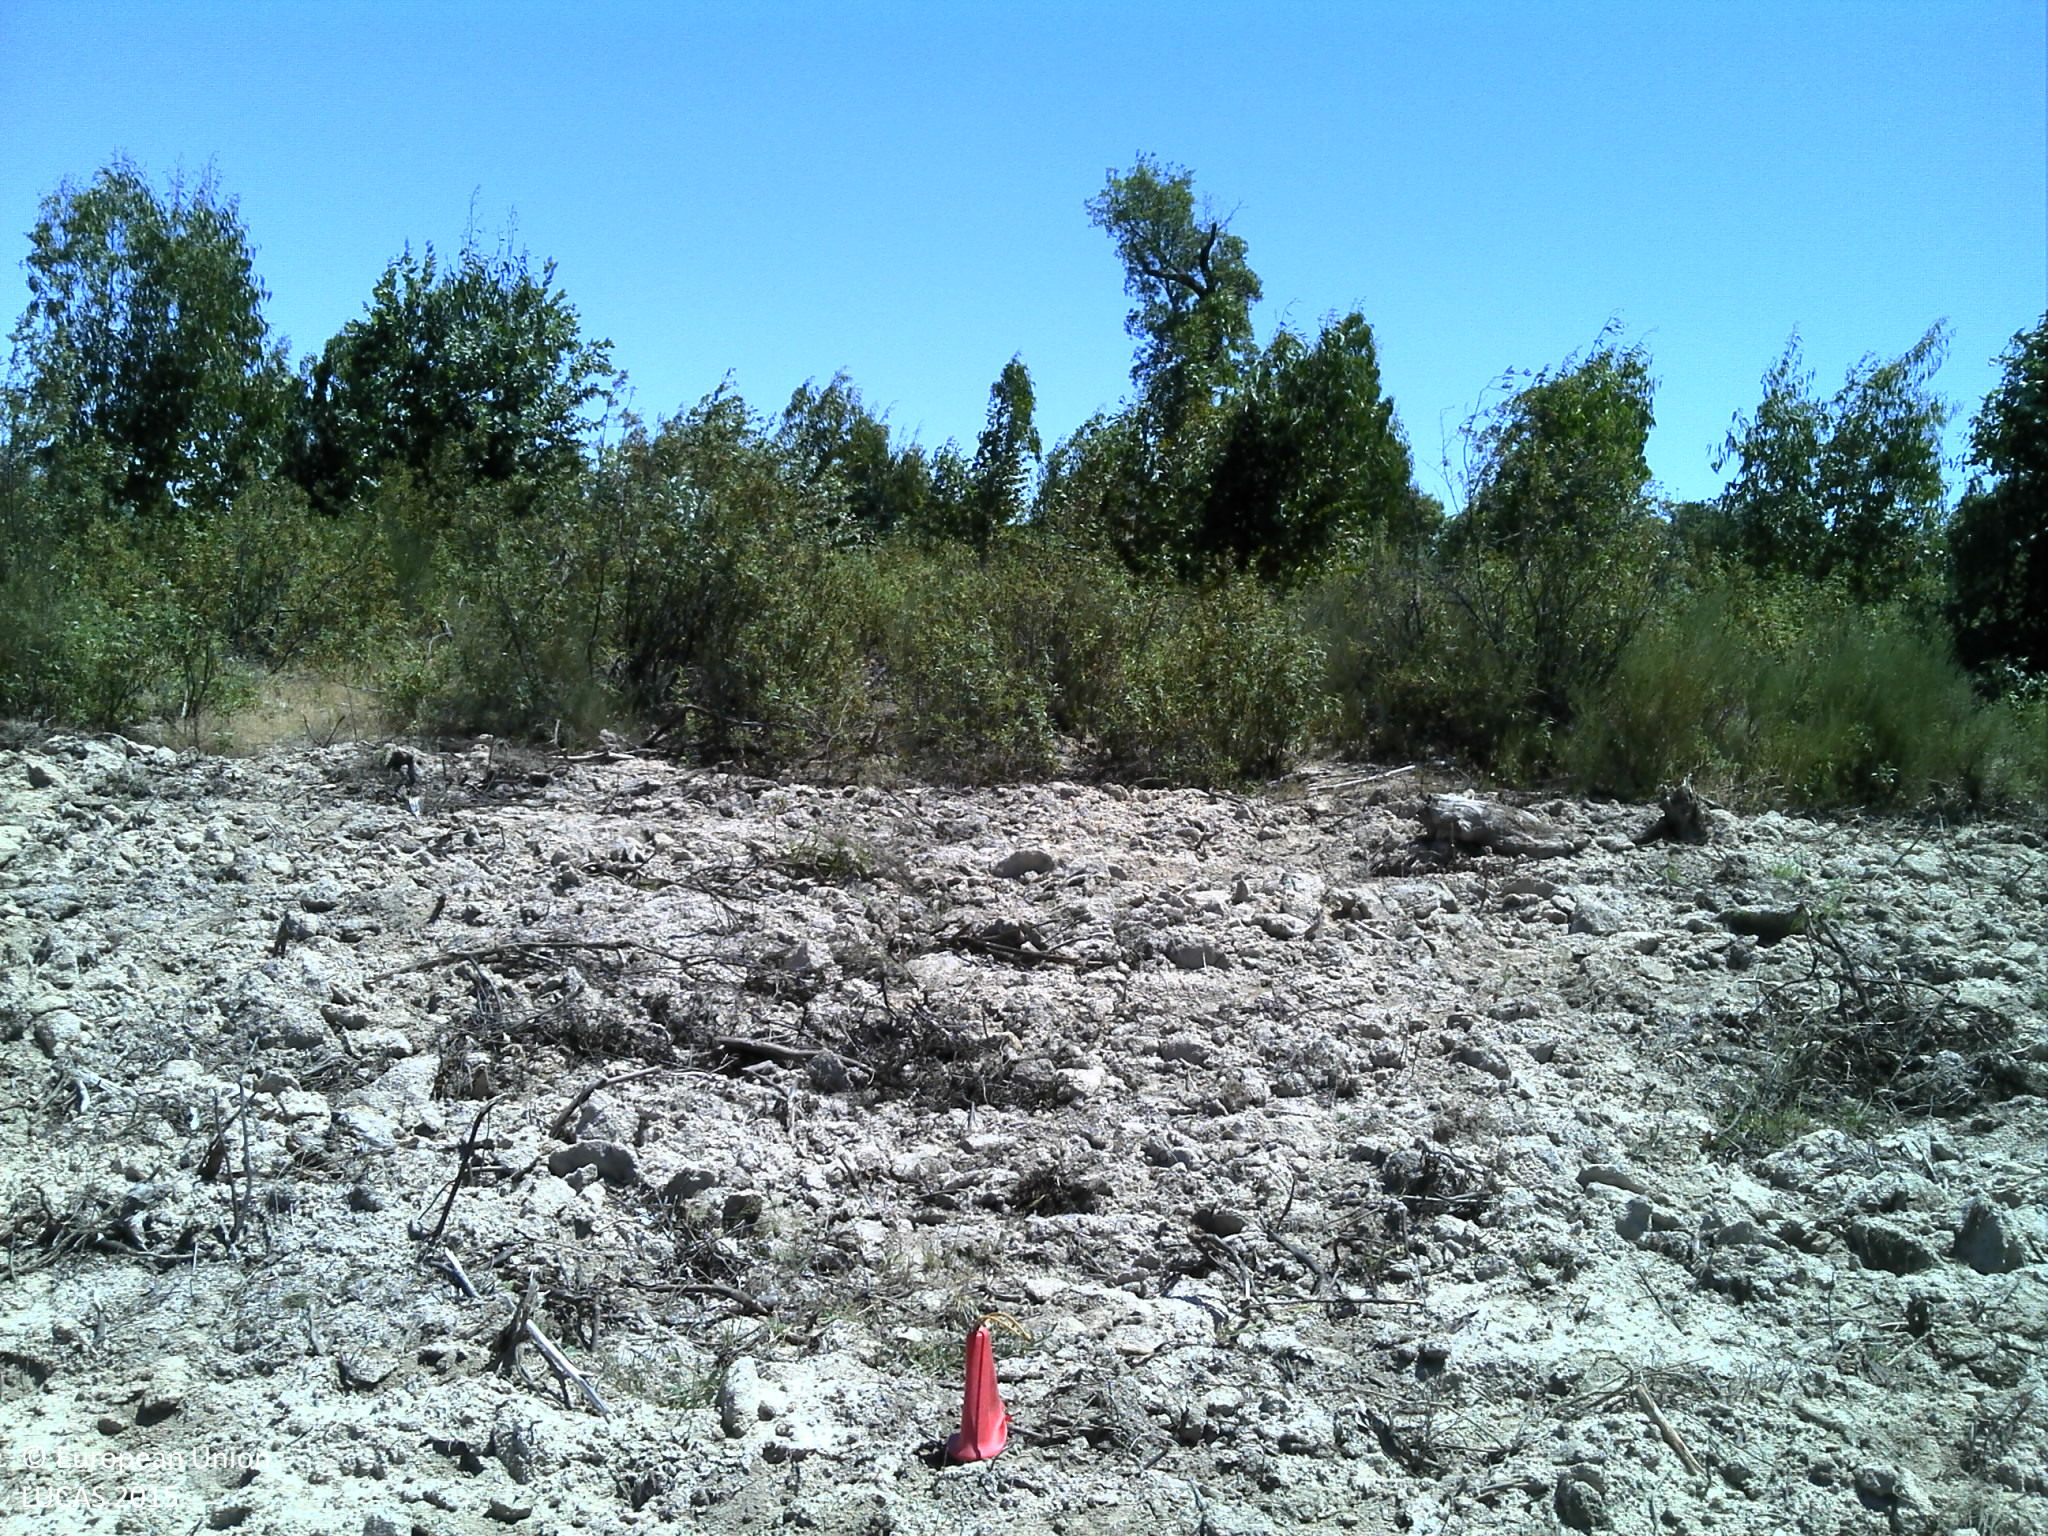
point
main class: Woodland
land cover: Broadleaved woodland
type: exotic forest
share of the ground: 10 - 25 %
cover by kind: unconsolidated bare surface 90 %, broadleaved forest trees 10 %
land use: Forestry
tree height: > 5 m
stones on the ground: < 10 %
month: May
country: PT
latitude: 39.4554
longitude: -7.7041
